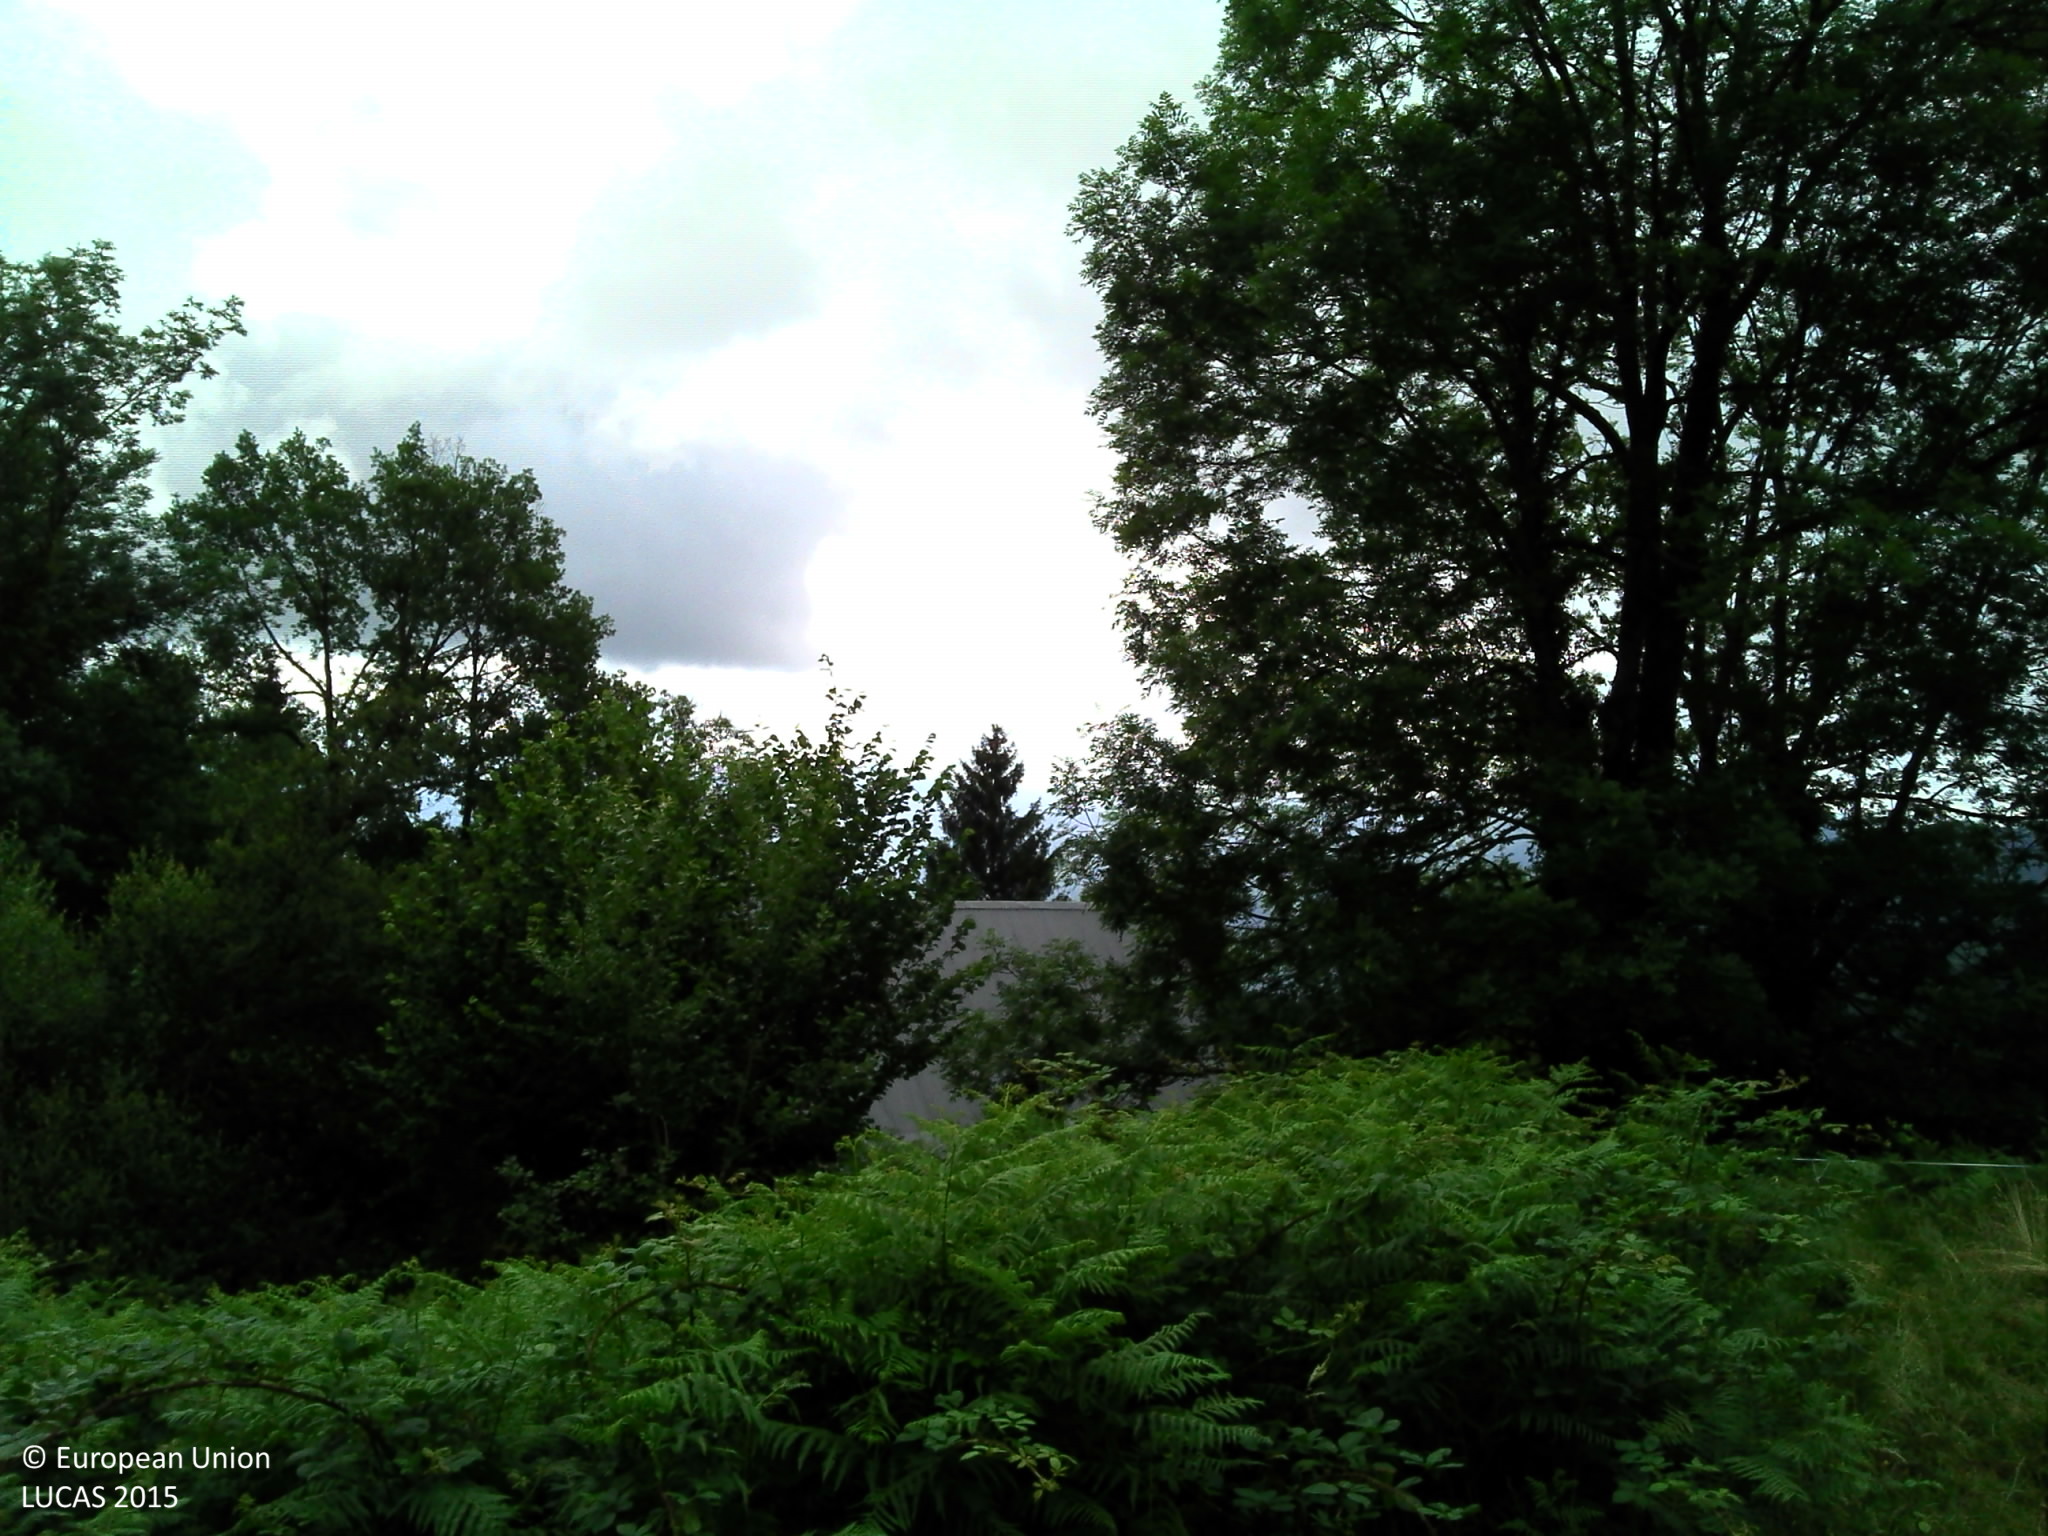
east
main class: Grassland
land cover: Grassland with sparse tree/shrub cover
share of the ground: > 75 %
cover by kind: herbaceous plants 90 %, broadleaved forest trees 5 %, shrubs 5 %
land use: Agriculture (excluding fallow land and kitchen gardens)
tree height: > 5 m
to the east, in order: Grassland with sparse tree/shrub cover; Artificial constructions in urban areas; Broadleaved woodland; Fences; Spontaneously vegetated surfaces; Artificial constructions in urban areas; Grassland with sparse tree/shrub cover; Broadleaved woodland; Fences; Tracks; Spontaneously vegetated surfaces; Broadleaved woodland
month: July
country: FR
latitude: 42.8835
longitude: 1.1533
